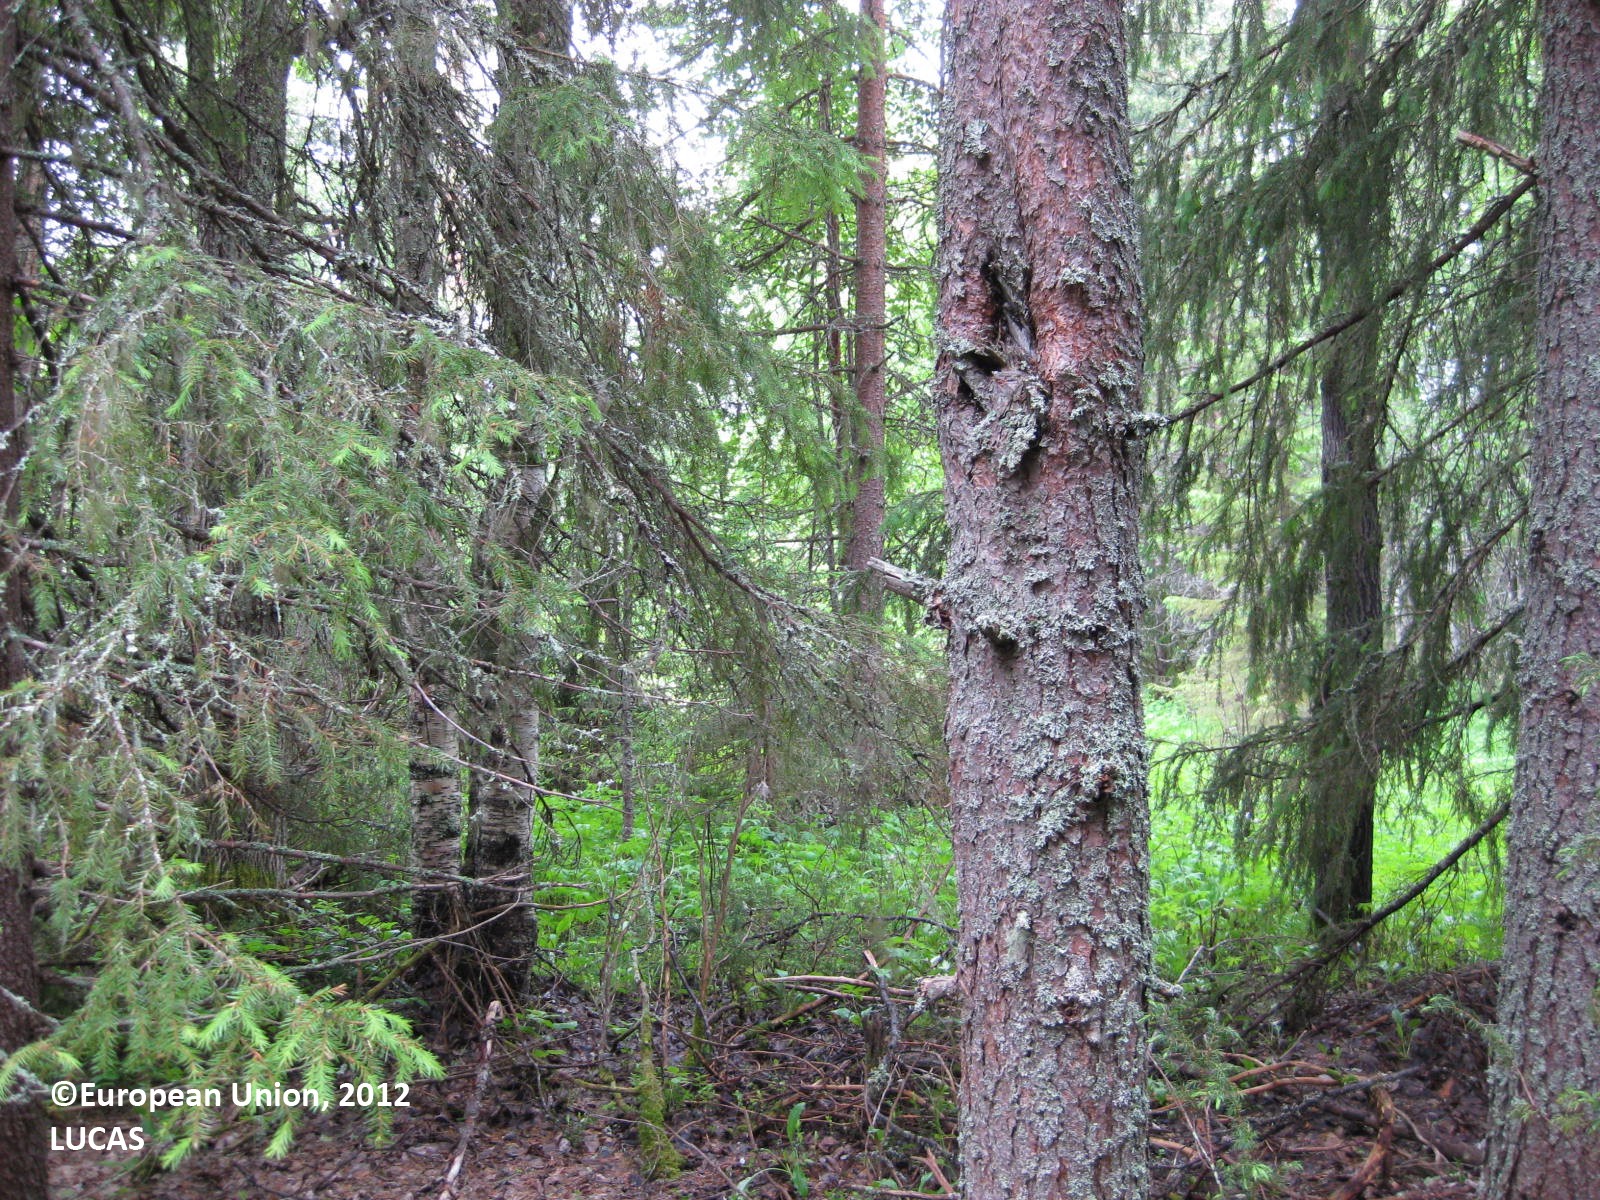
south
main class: Woodland
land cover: Other coniferous woodland
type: boreal forest
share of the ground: > 75 %
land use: Forestry
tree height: > 5 m
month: June
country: FI
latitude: 65.2357
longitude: 28.1912
